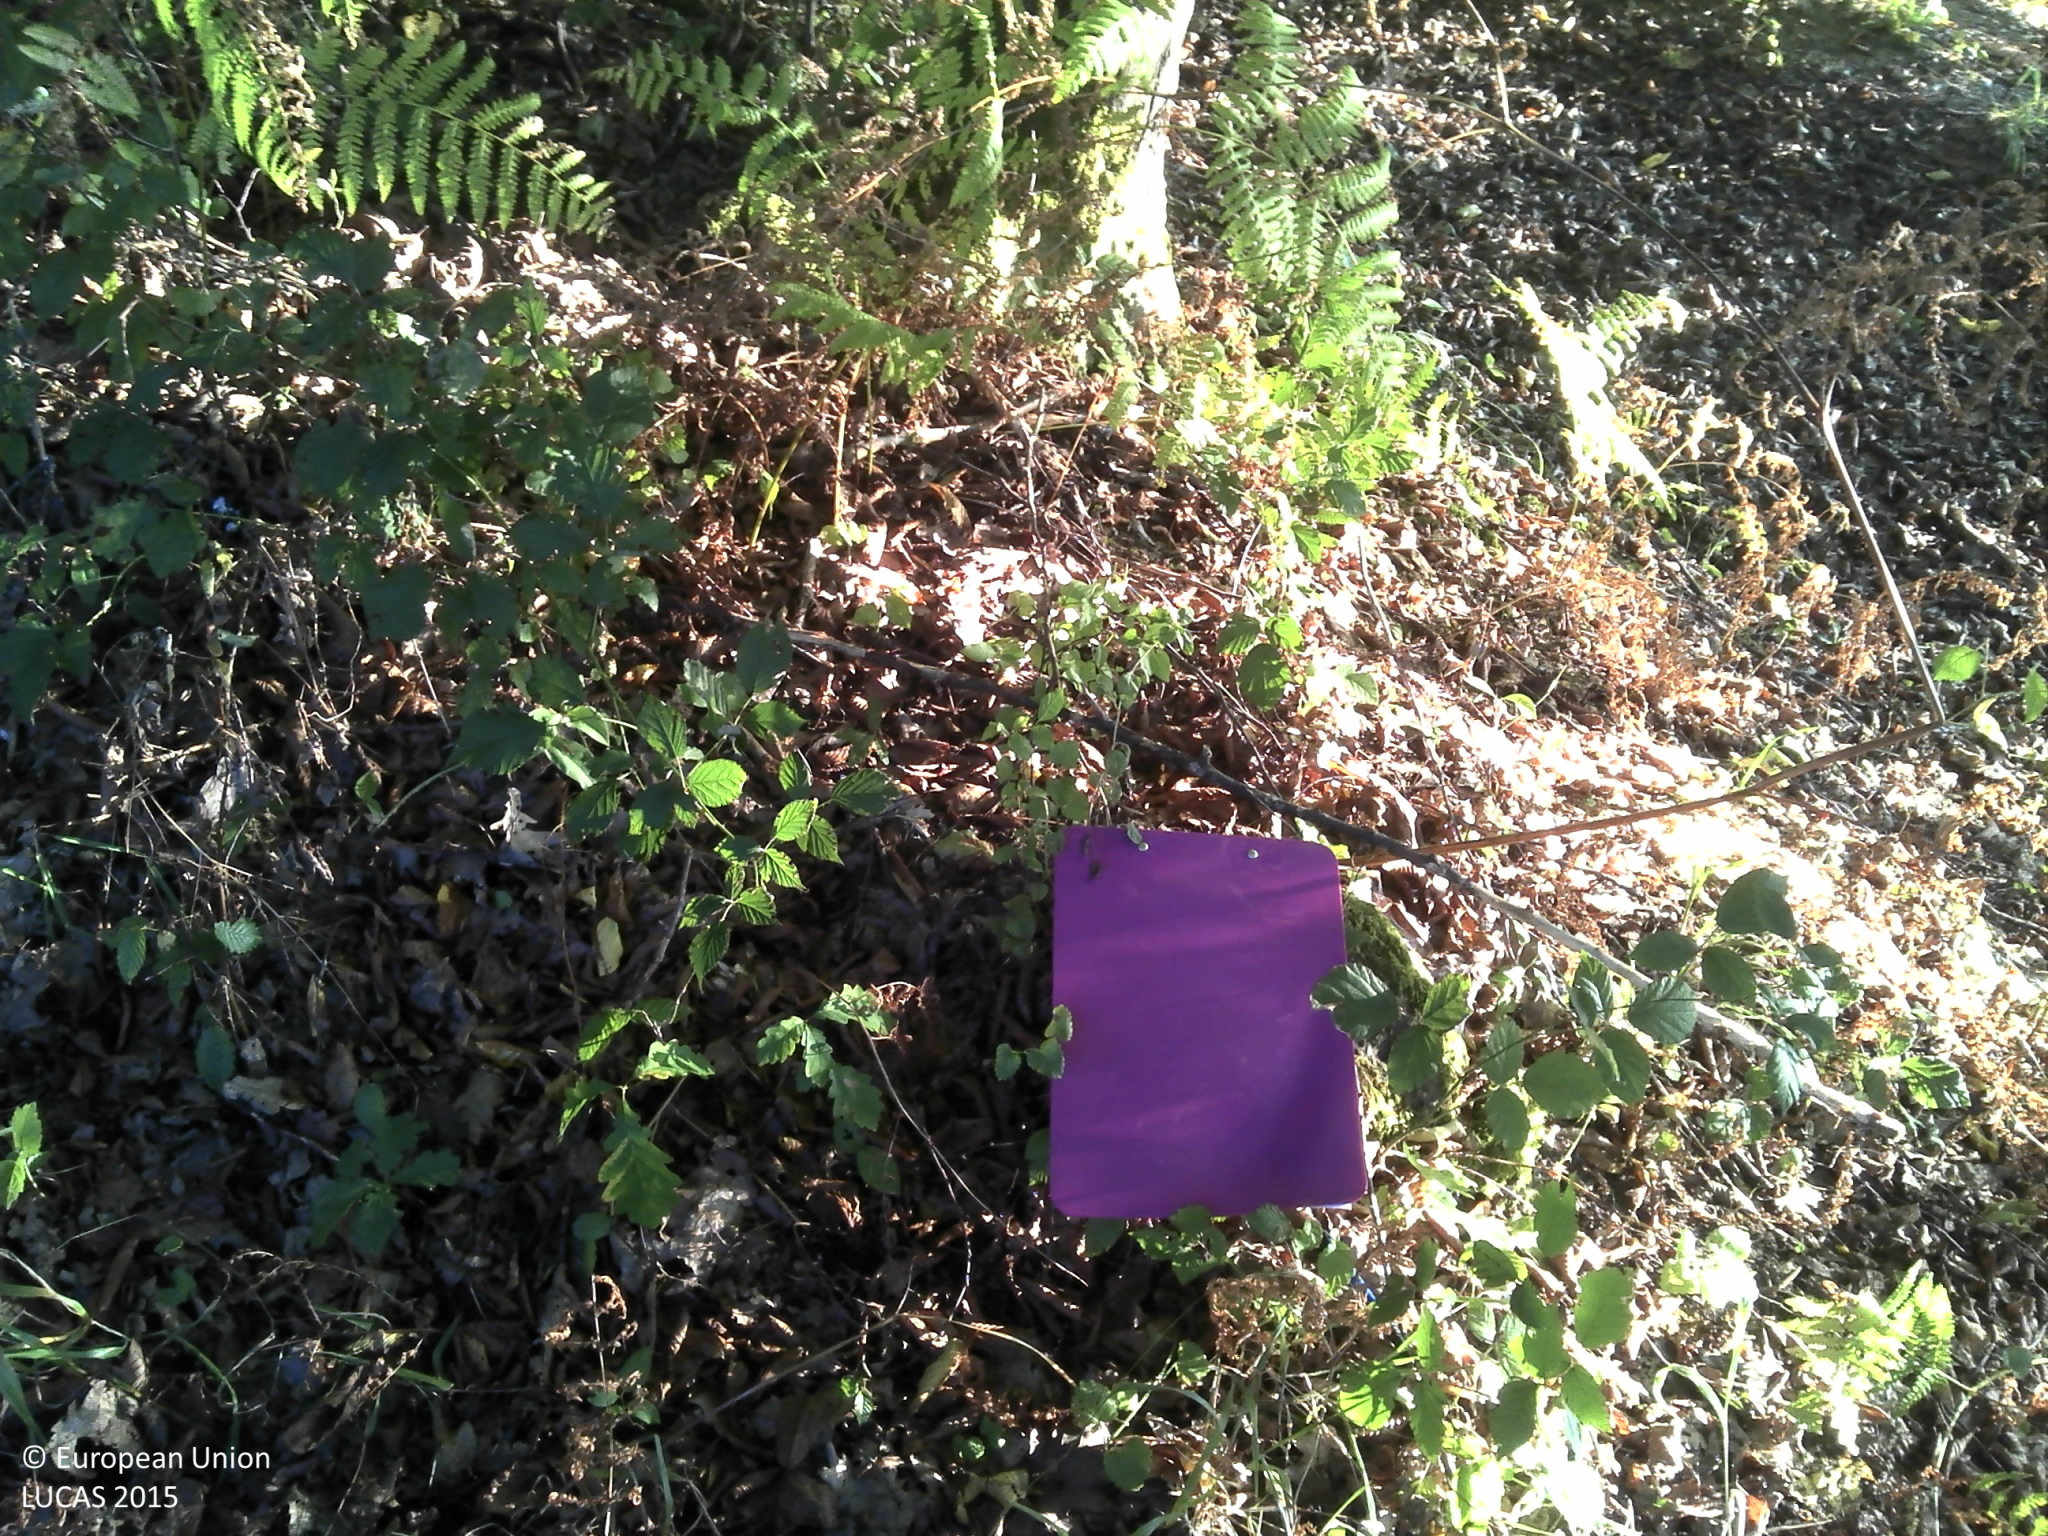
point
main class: Shrubland
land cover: Shrubland with sparse tree cover
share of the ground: > 75 %
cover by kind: shrubs 90 %, broadleaved forest trees 5 %, herbaceous plants 5 %
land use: Semi-natural and natural areas not in use
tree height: < 5 m
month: August
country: HR
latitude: 45.2976
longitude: 16.3093
